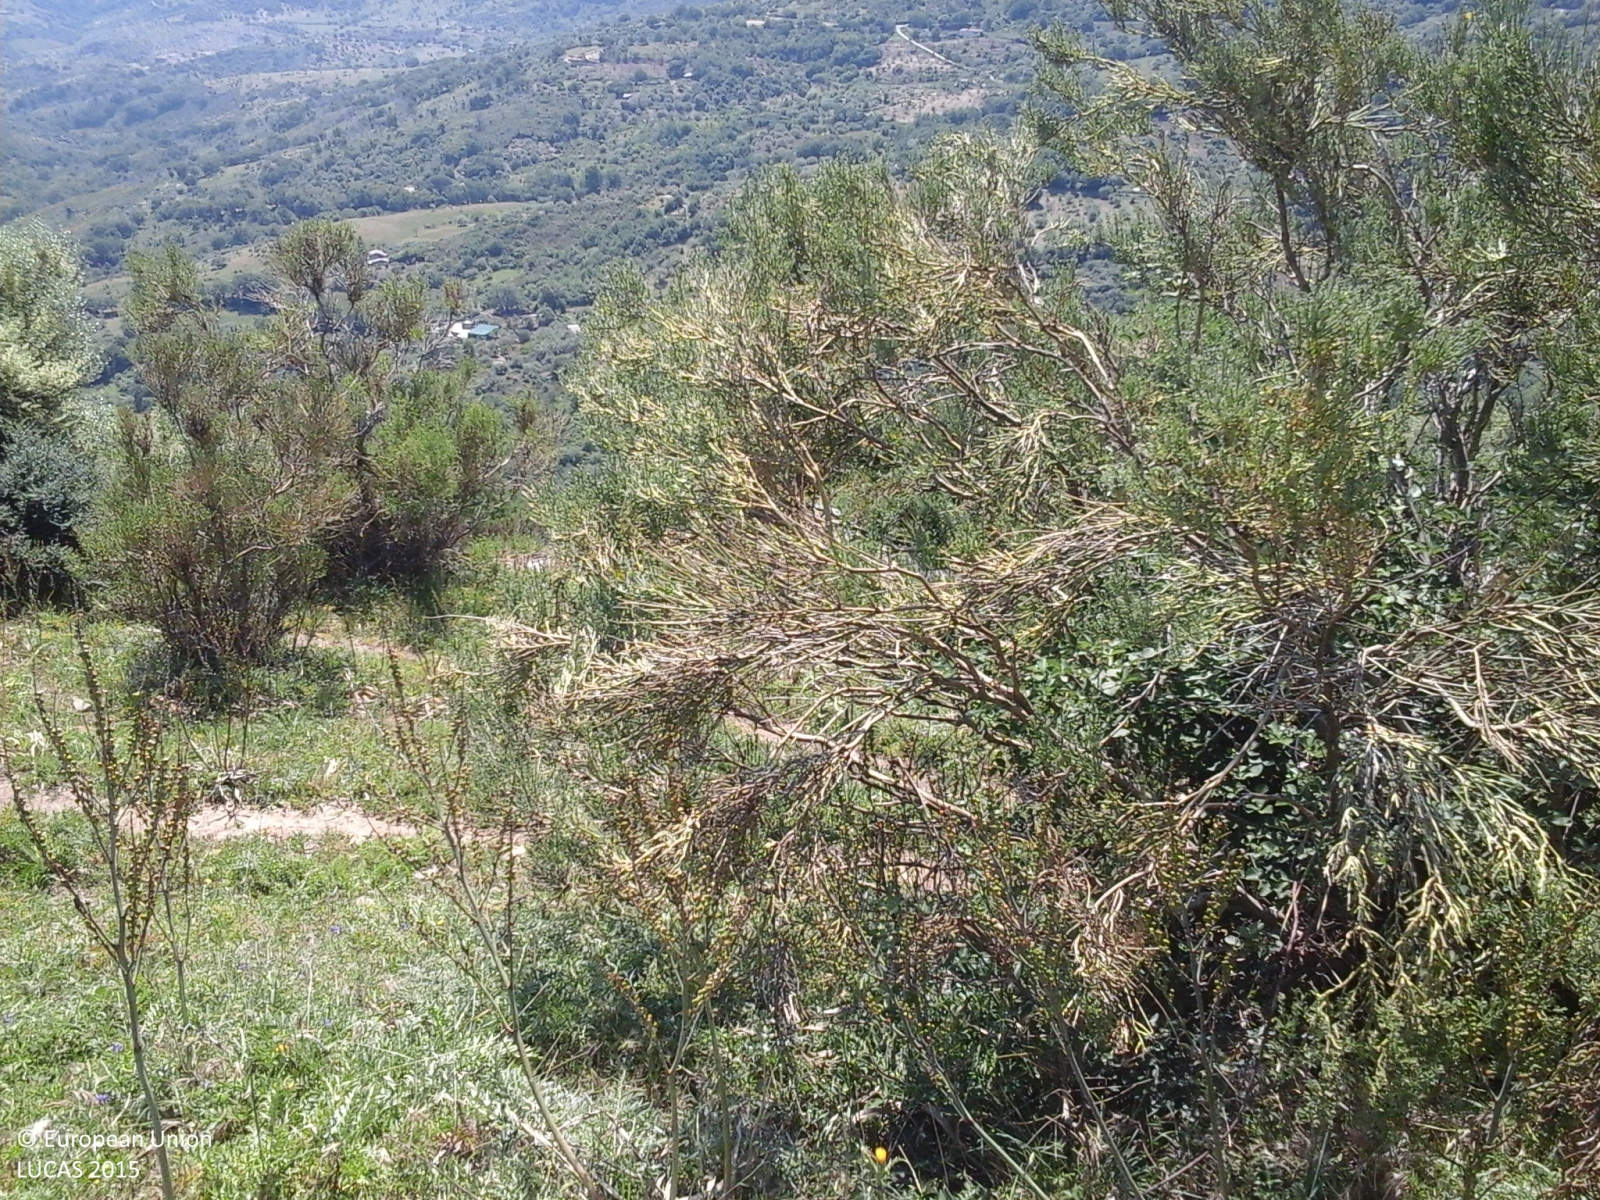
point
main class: Shrubland
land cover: Shrubland with sparse tree cover
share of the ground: > 75 %
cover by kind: shrubs 55 %, herbaceous plants 40 %, broadleaved forest trees 5 %
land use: Agriculture (excluding fallow land and kitchen gardens)
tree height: < 5 m
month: June
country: IT
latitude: 37.9536
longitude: 14.0121
